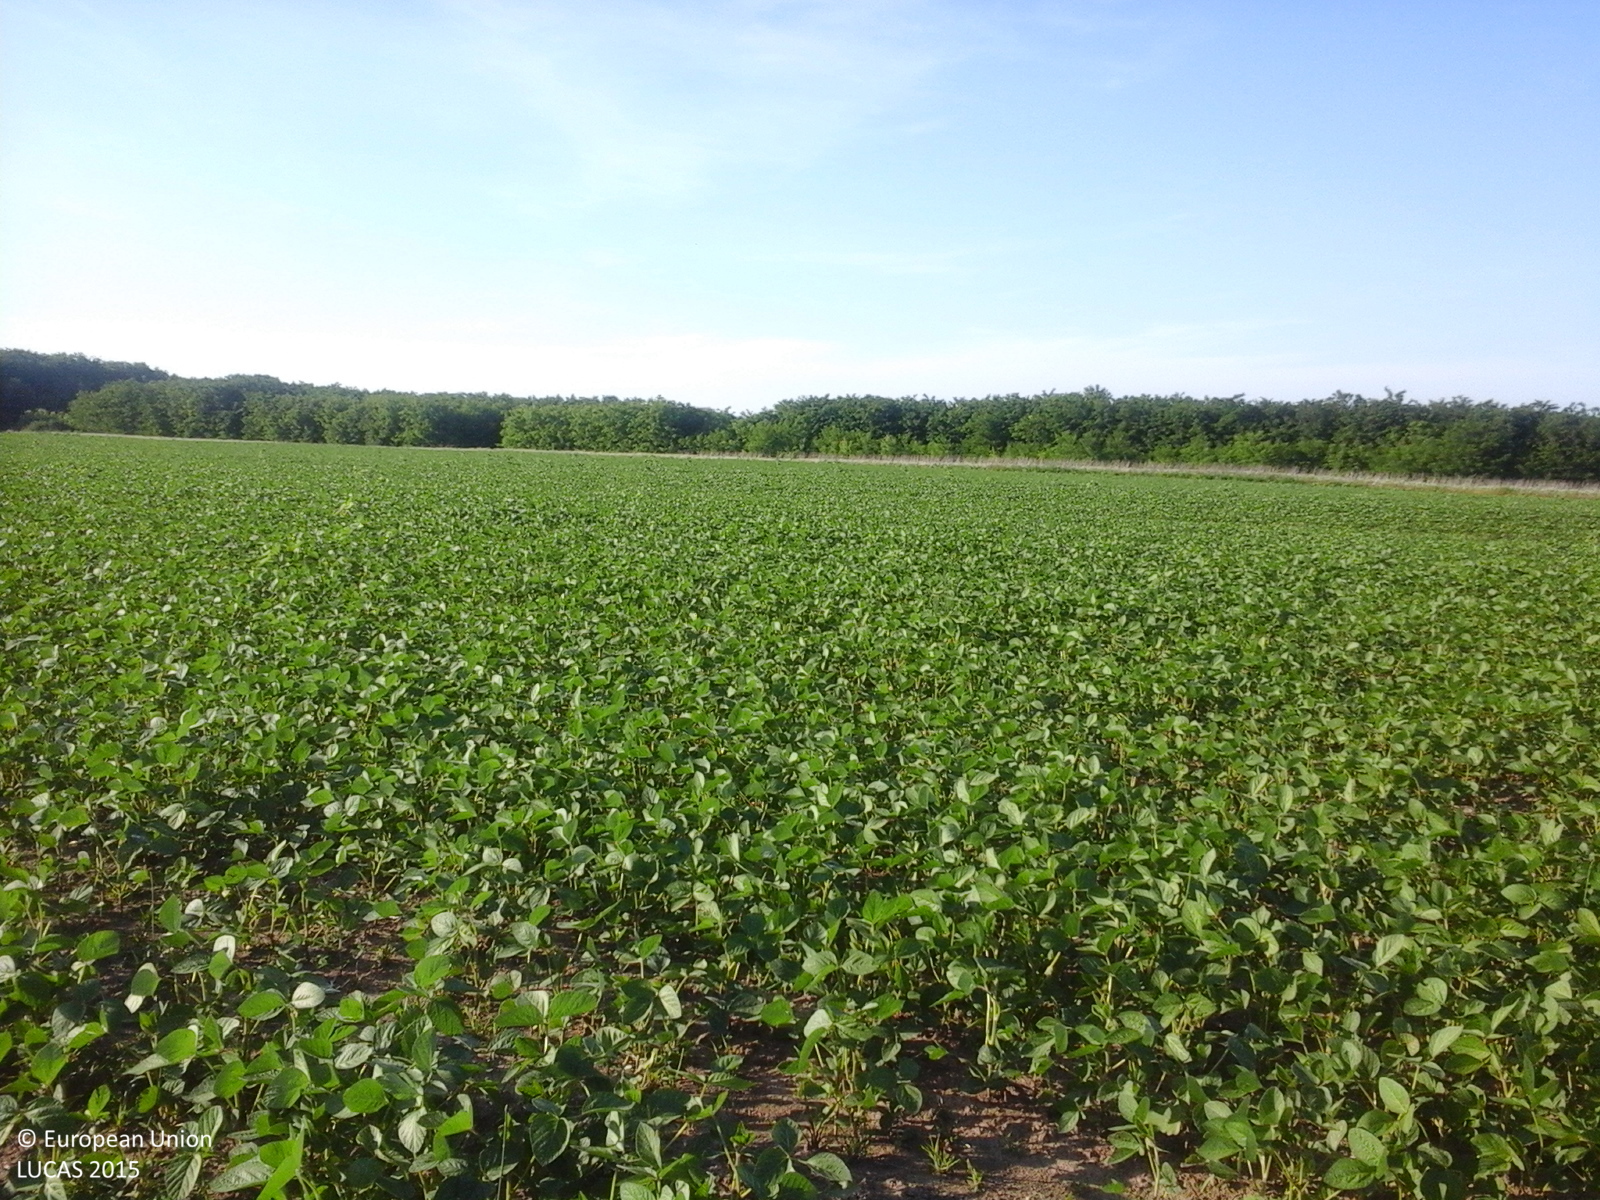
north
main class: Cropland
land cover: Soya
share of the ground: > 75 %
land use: Agriculture (excluding fallow land and kitchen gardens)
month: June
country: RO
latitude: 47.7684
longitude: 27.2587
